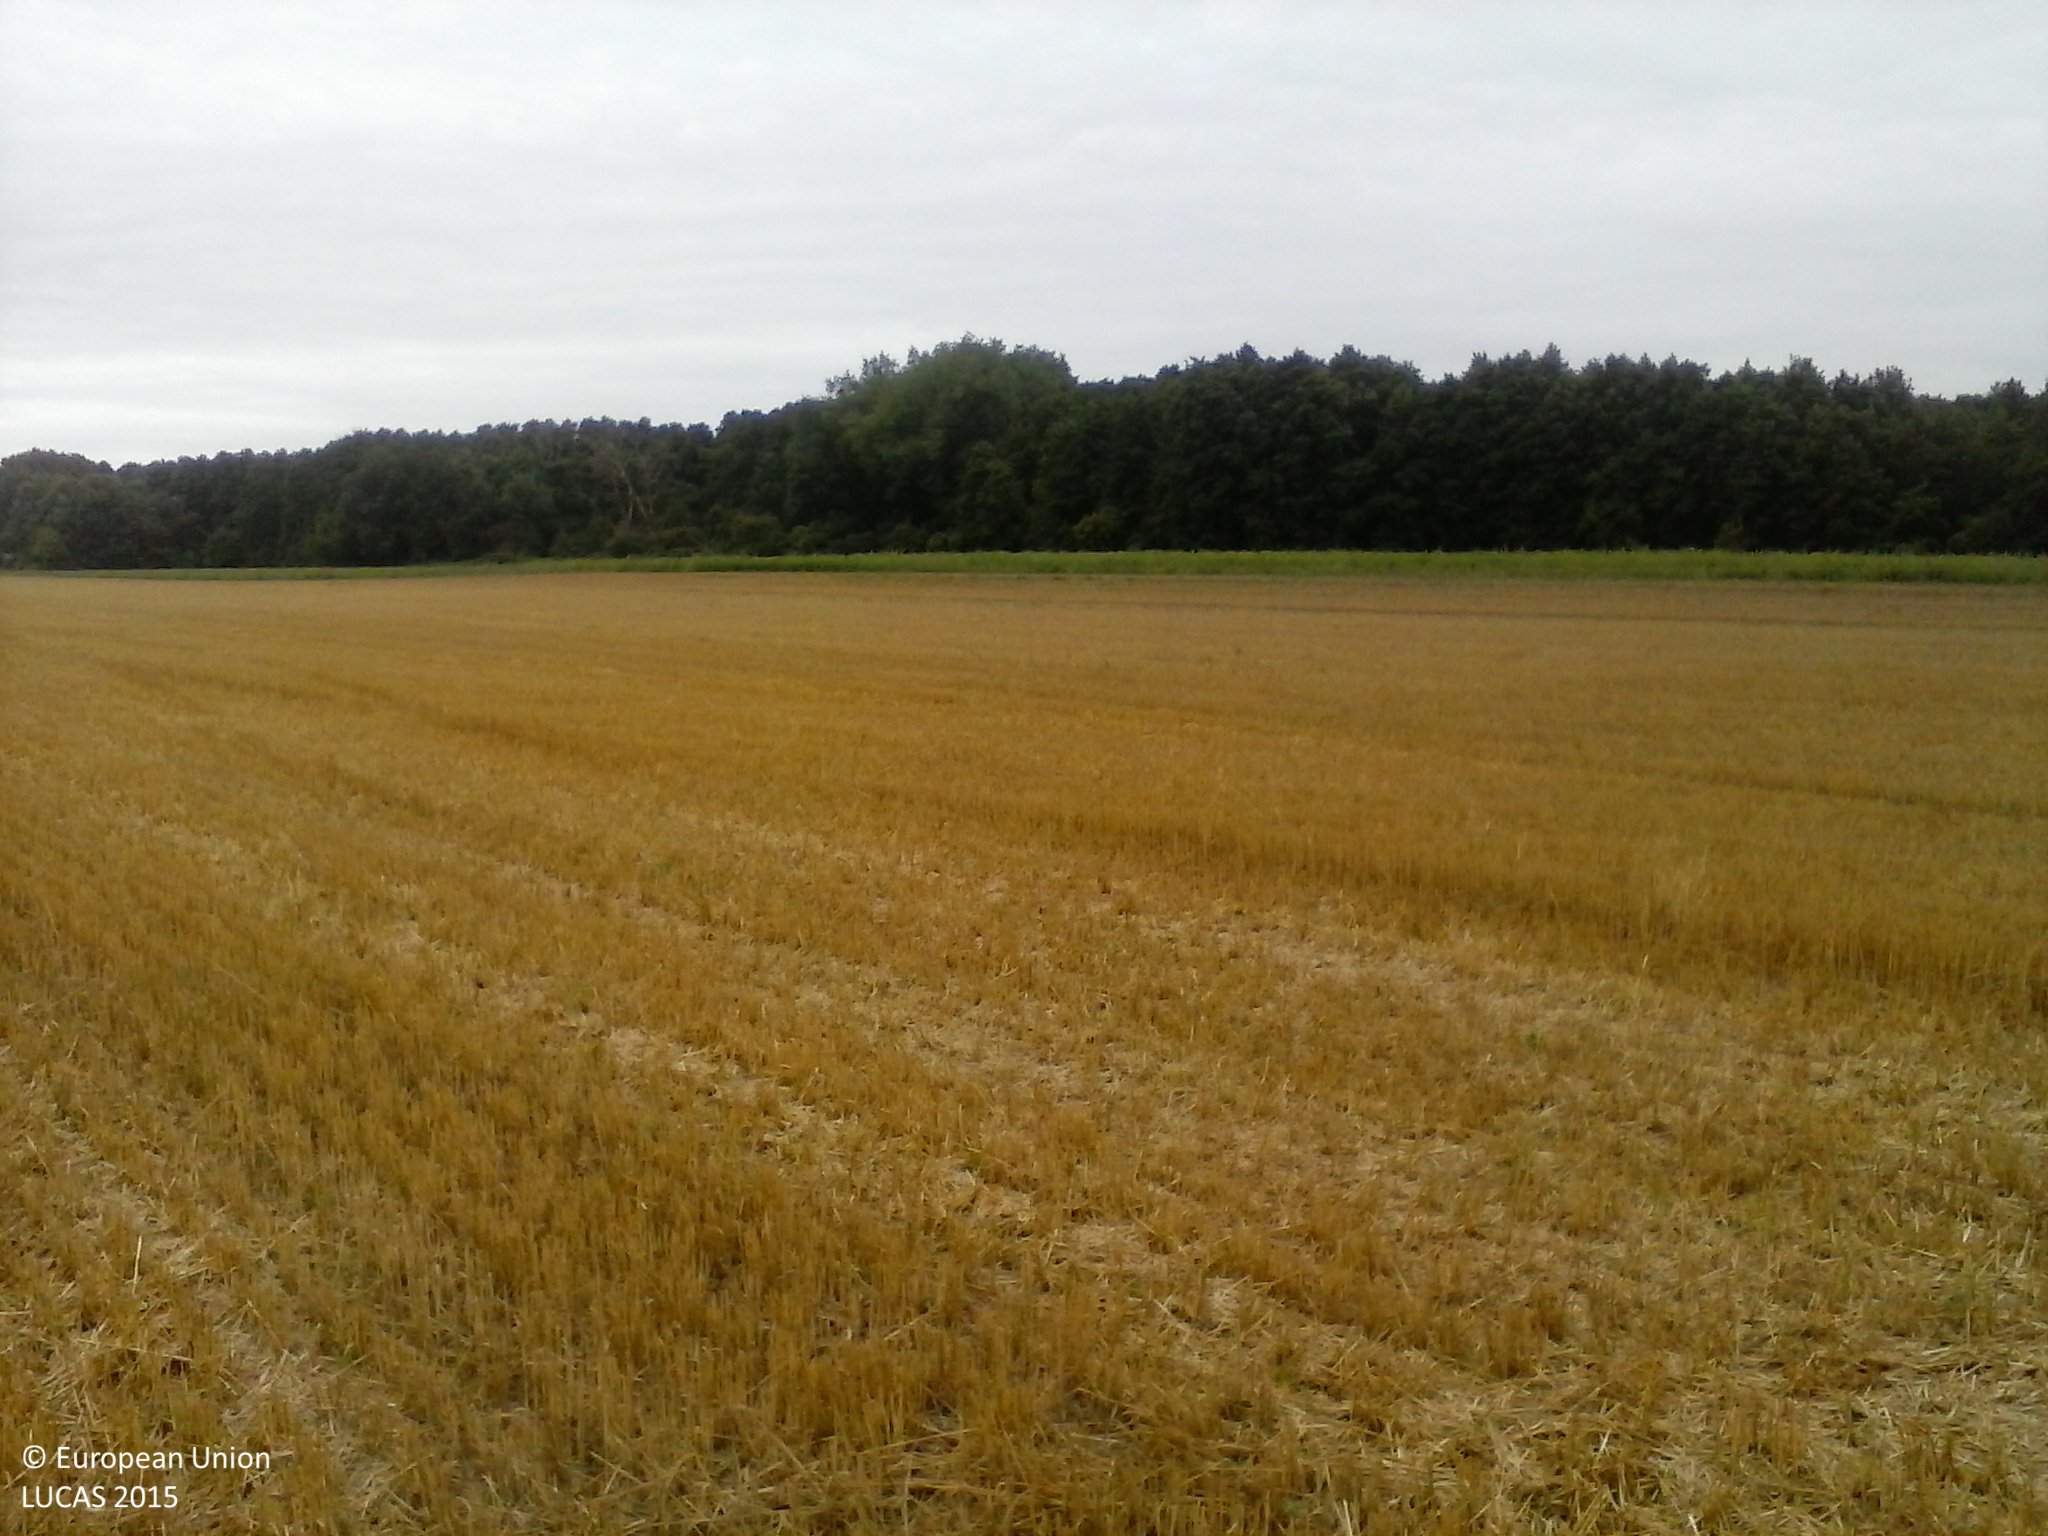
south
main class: Cropland
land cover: Common wheat
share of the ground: > 75 %
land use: Agriculture (excluding fallow land and kitchen gardens)
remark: Harvested field
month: July
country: HU
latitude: 46.0773
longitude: 17.6461
